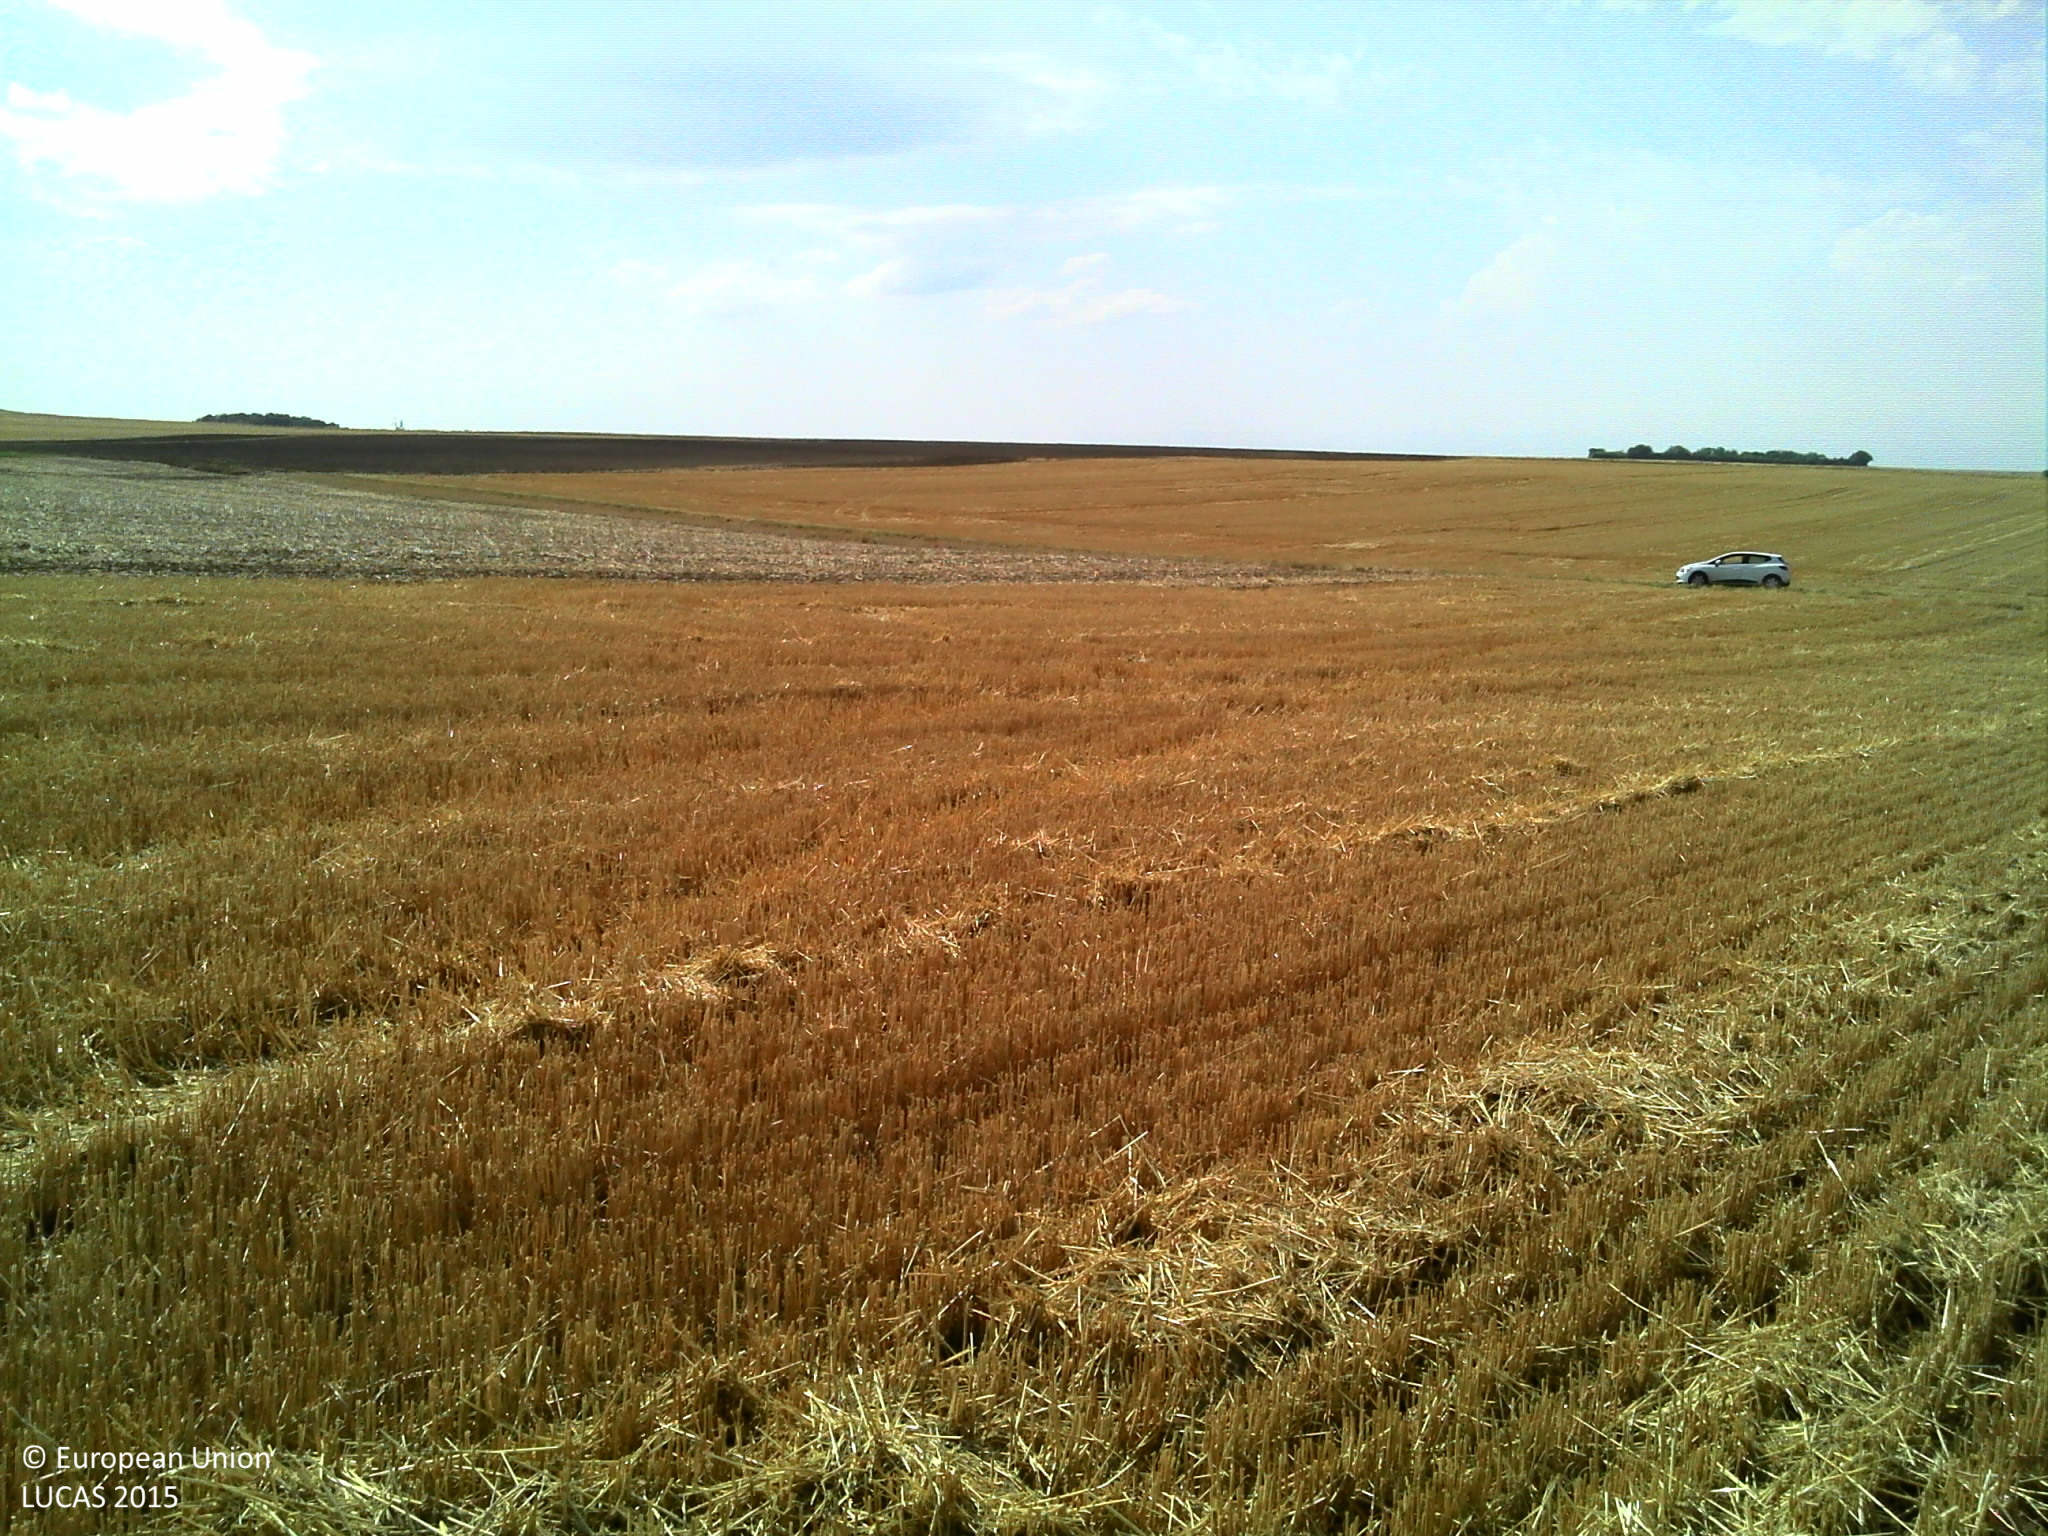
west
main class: Cropland
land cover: Common wheat
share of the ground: > 75 %
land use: Agriculture (excluding fallow land and kitchen gardens)
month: August
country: FR
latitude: 47.8472
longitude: 3.4337
